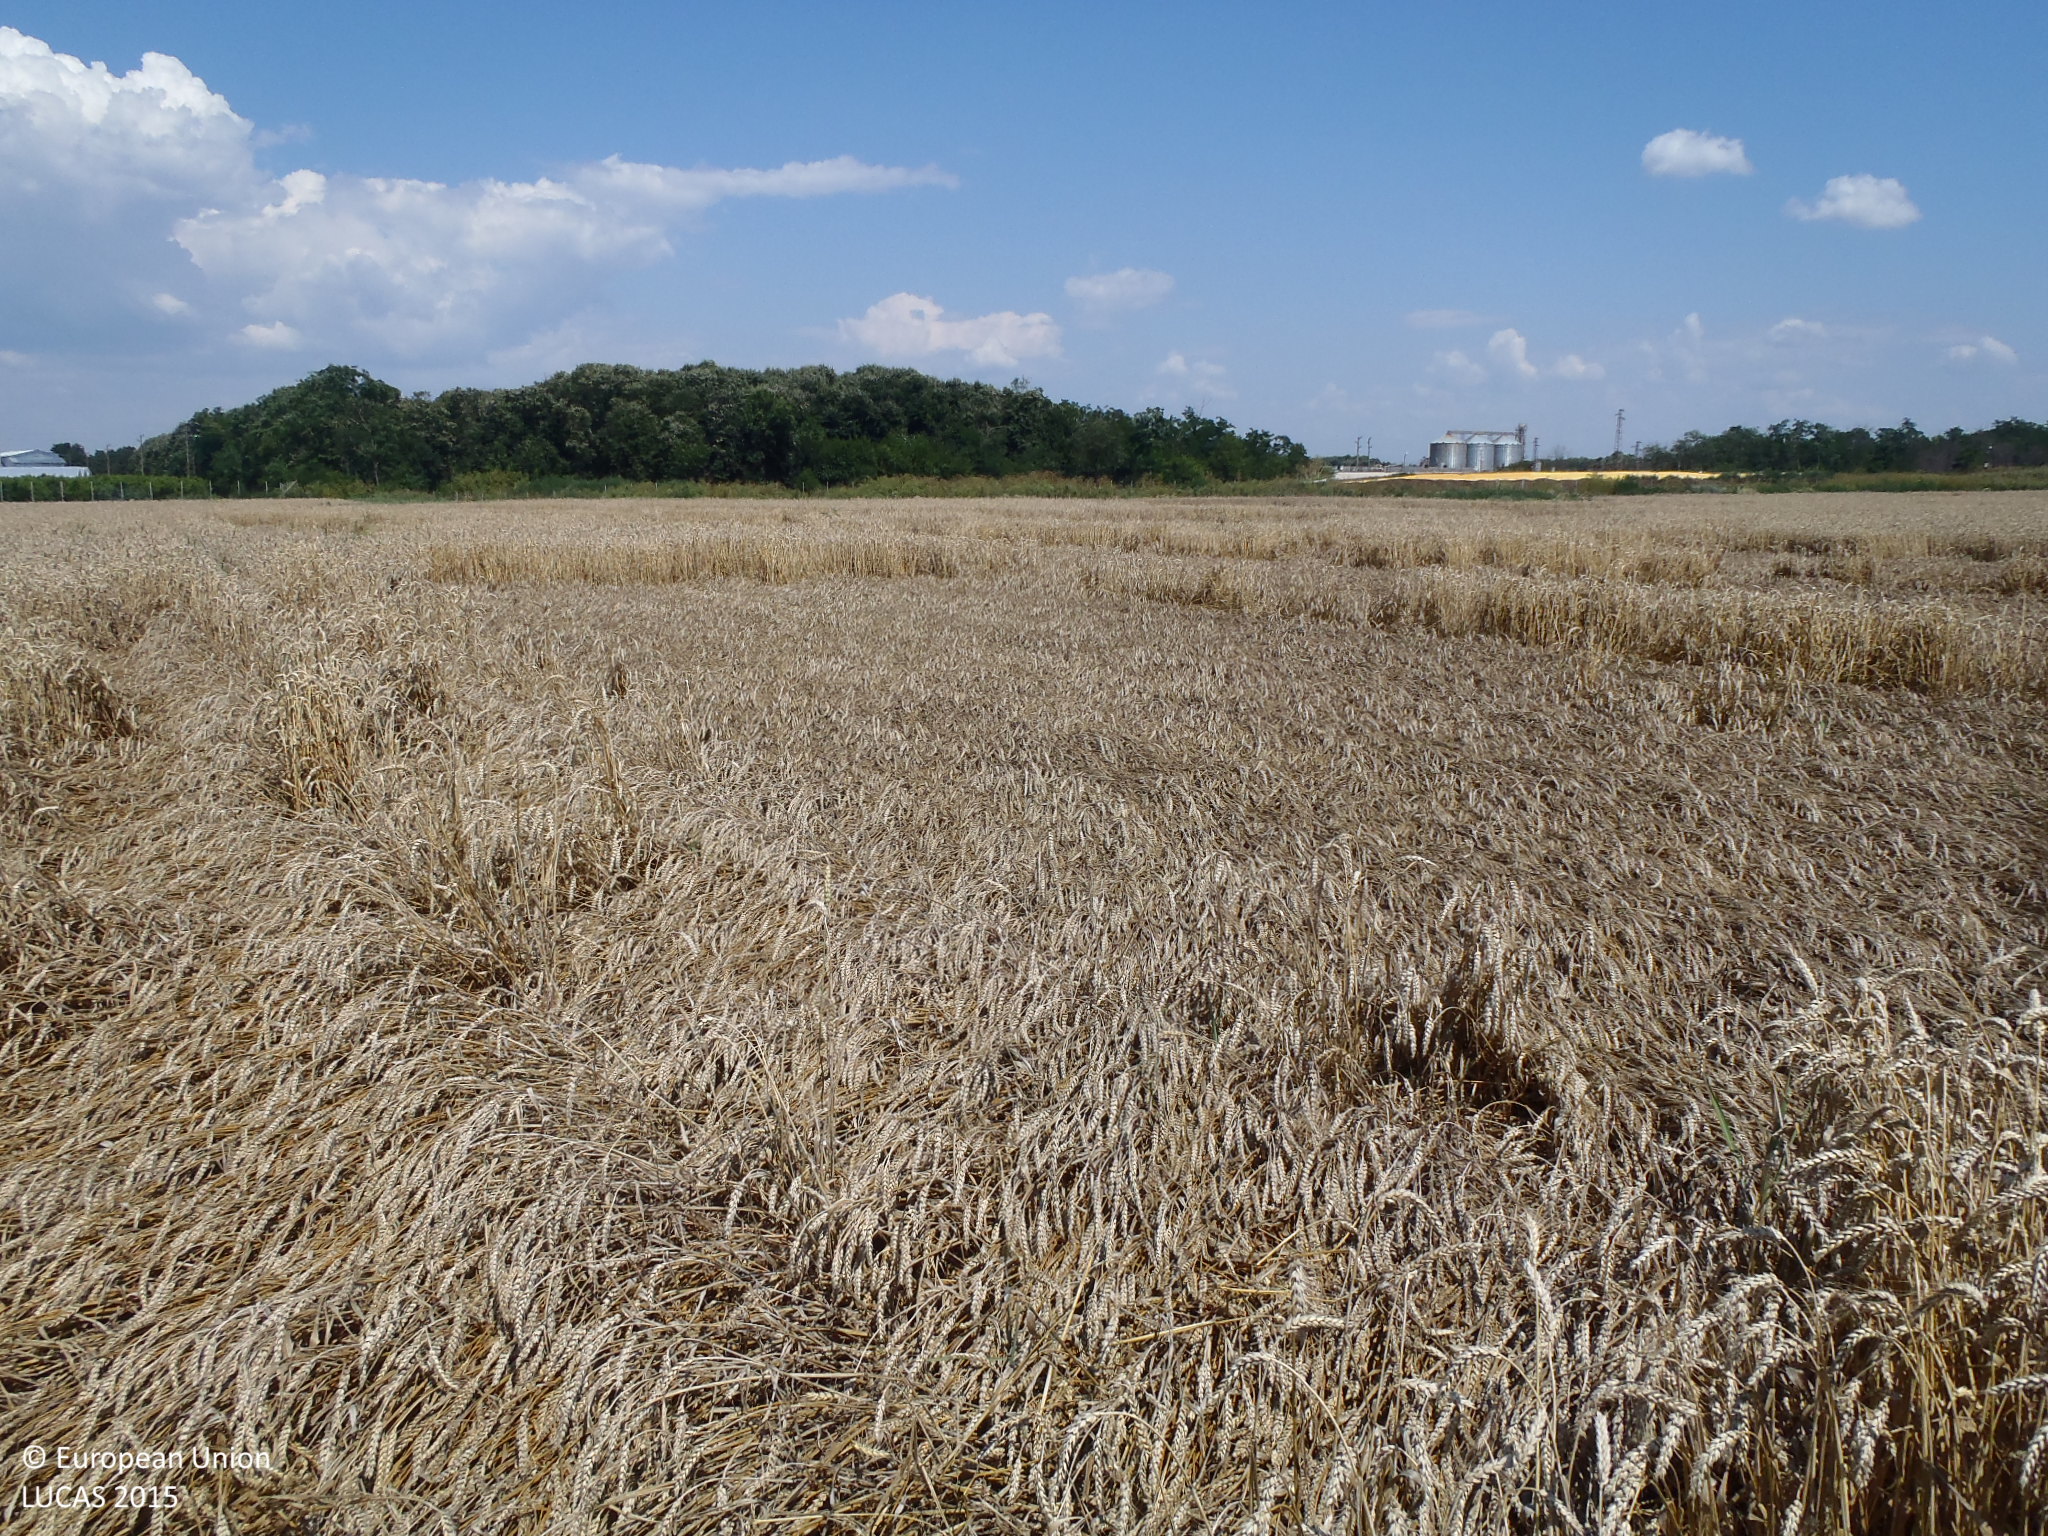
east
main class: Cropland
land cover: Common wheat
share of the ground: > 75 %
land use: Agriculture (excluding fallow land and kitchen gardens)
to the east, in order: Common wheat; Grass margins; Tracks; Grassland with sparse tree/shrub cover; Artificial constructions in urban areas; Broadleaved woodland; Artificial constructions in urban areas
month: July
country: BG
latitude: 43.9665
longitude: 26.3210
